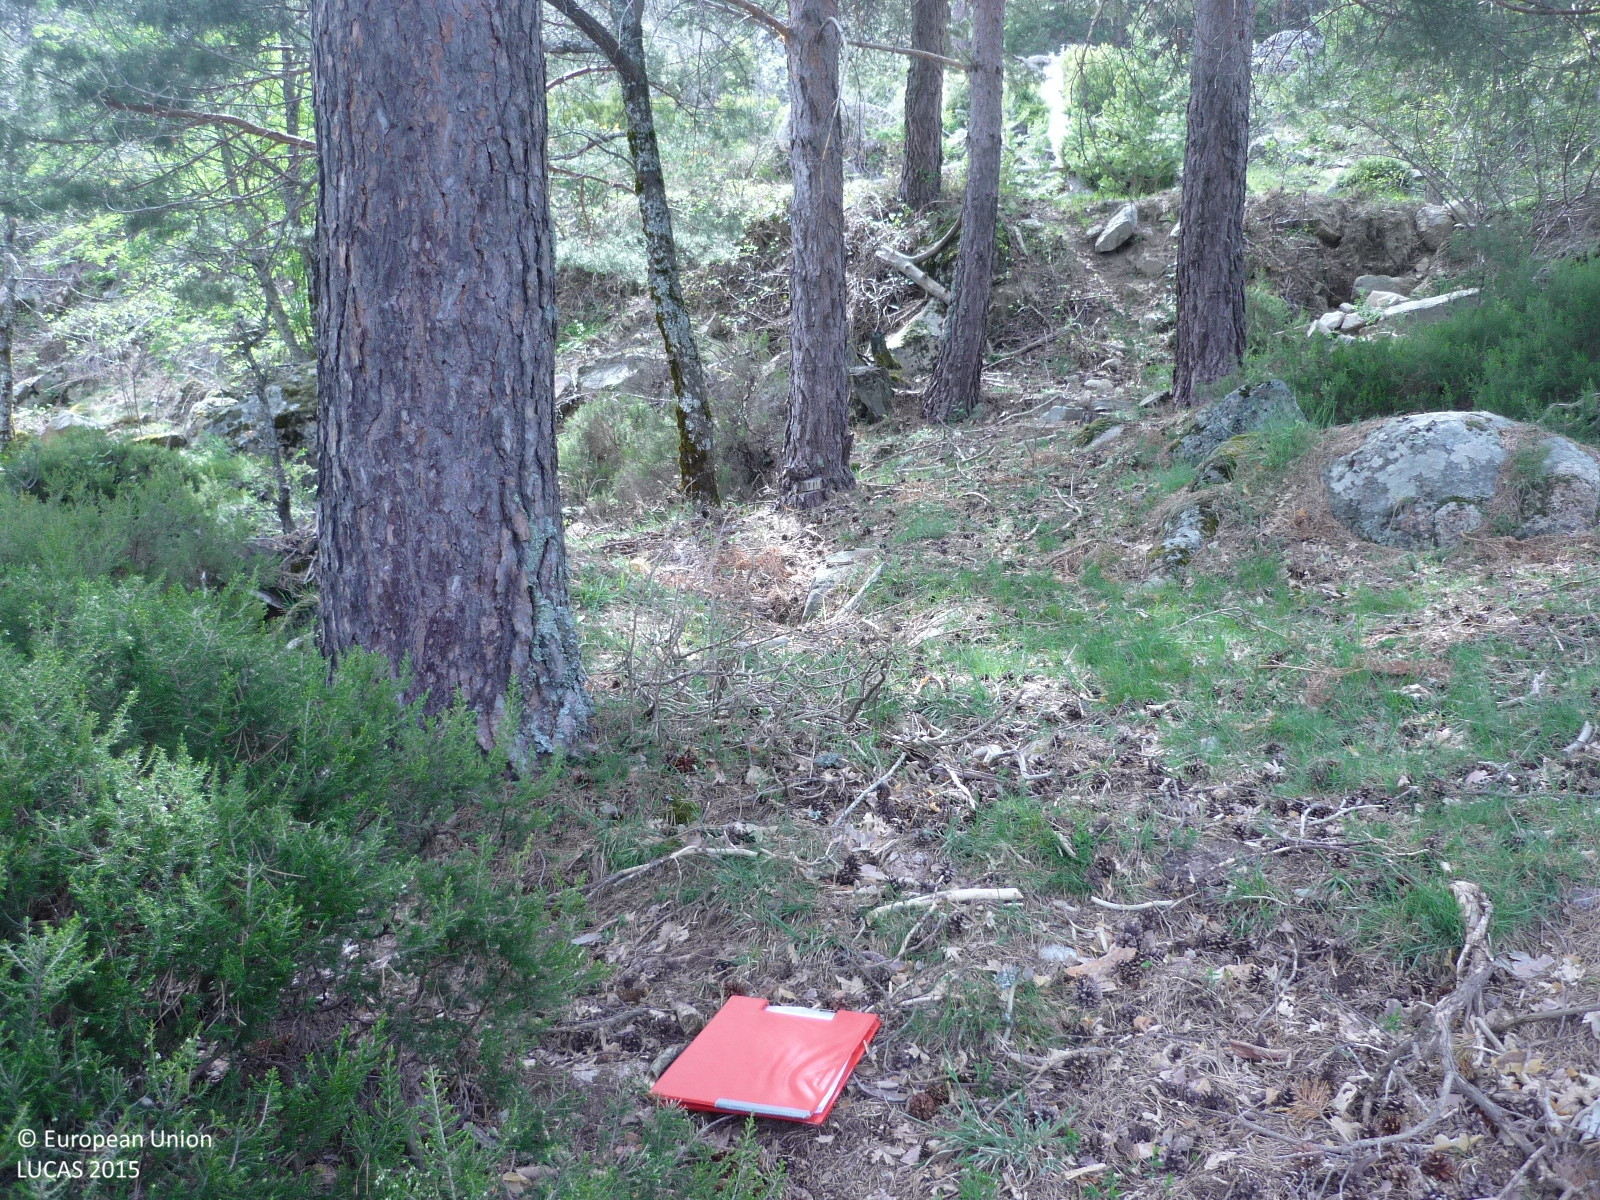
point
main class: Woodland
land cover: Pine dominated coniferous woodland
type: coniferous forest of the mediterranean region
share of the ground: > 75 %
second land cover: Grassland without tree/shrub cover
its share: 25 - 50 %
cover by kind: coniferous forest trees 85 %, shrubs 10 %, herbaceous plants 5 %
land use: Forestry
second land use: Agriculture (excluding fallow land and kitchen gardens)
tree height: > 5 m
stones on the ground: < 10 %
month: May
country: ES
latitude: 40.8821
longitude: -3.9195
